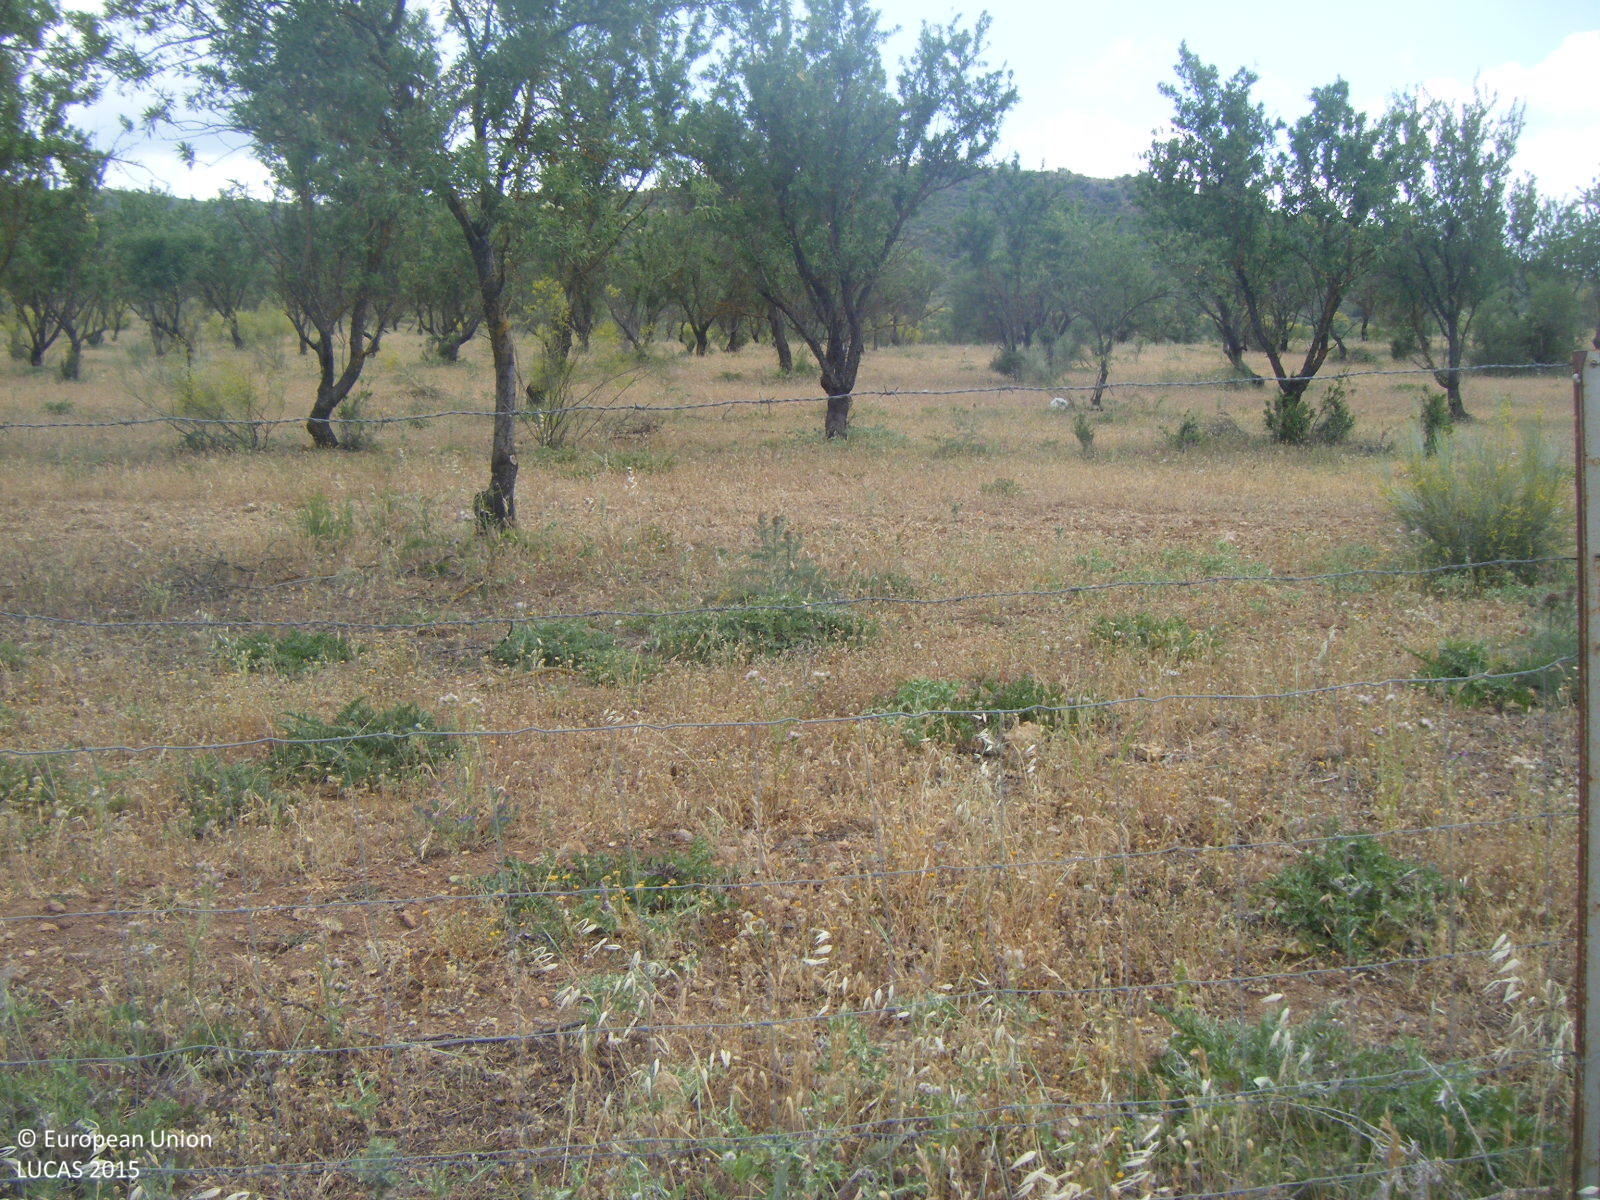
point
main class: Cropland
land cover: Nuts trees
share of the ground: 10 - 25 %
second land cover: Spontaneously vegetated surfaces
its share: > 75 %
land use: Agriculture (excluding fallow land and kitchen gardens)
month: May
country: ES
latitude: 37.0754
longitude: -4.4730
